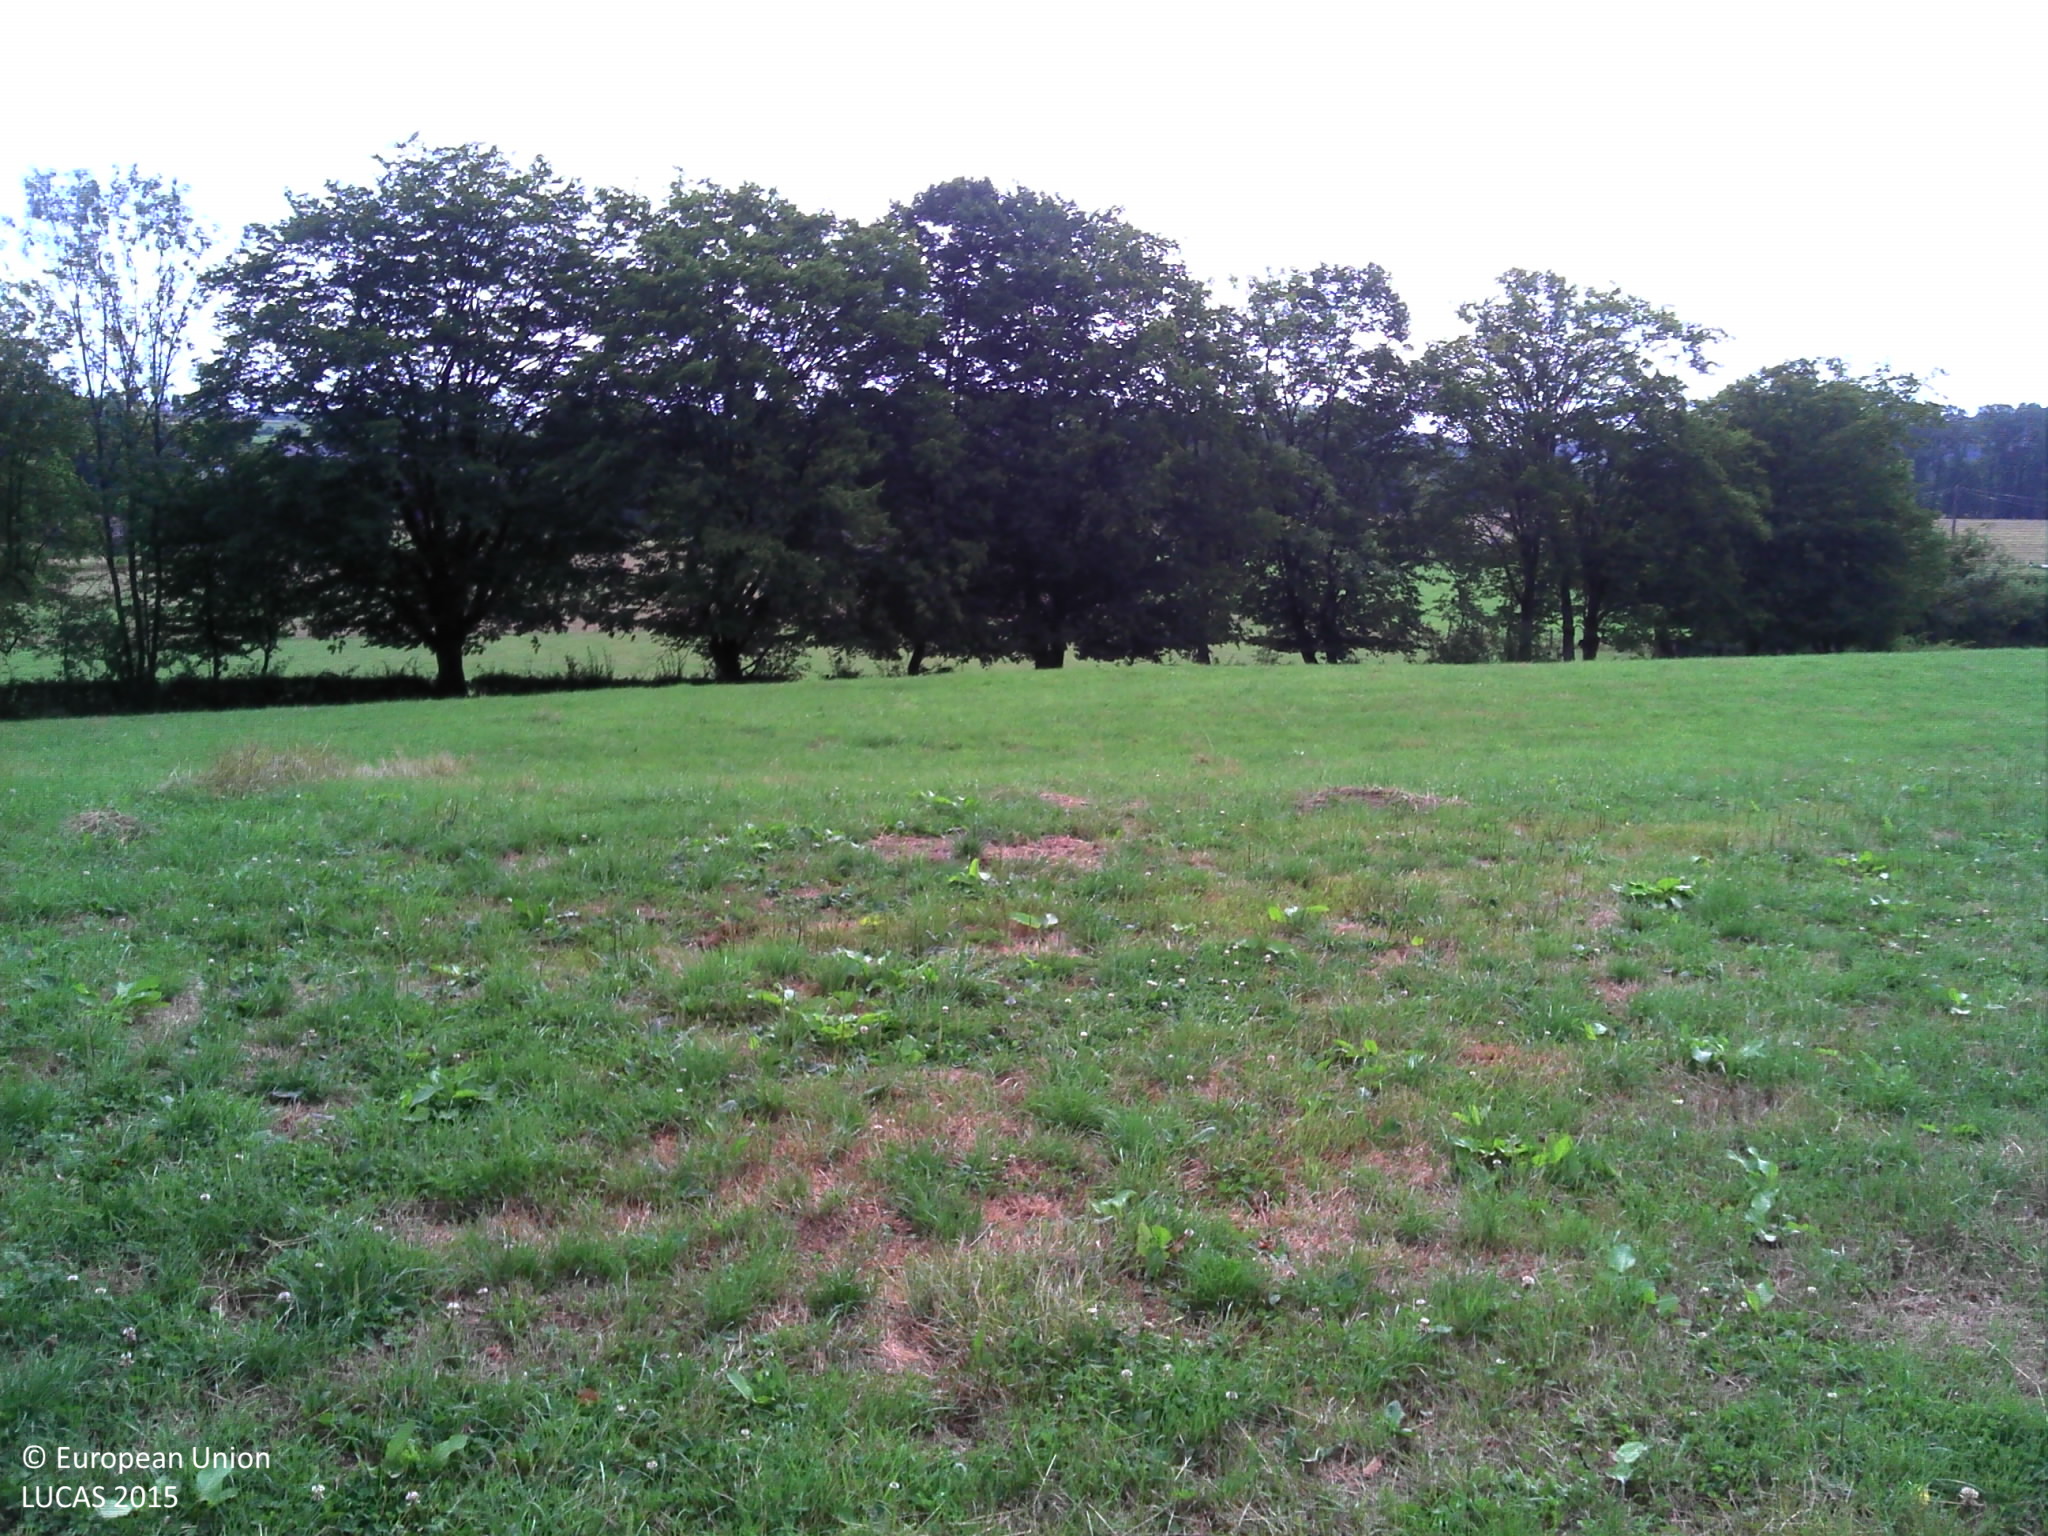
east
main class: Grassland
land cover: Grassland without tree/shrub cover
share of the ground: > 75 %
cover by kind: herbaceous plants 100 %
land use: Agriculture (excluding fallow land and kitchen gardens)
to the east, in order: Grassland without tree/shrub cover; Lines of trees; Grassland without tree/shrub cover; Fences; Grassland without tree/shrub cover; Single bushes/trees; Grassland without tree/shrub cover; Managed hedges; Grassland without tree/shrub cover
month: July
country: BE
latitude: 49.7090
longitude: 5.2970
